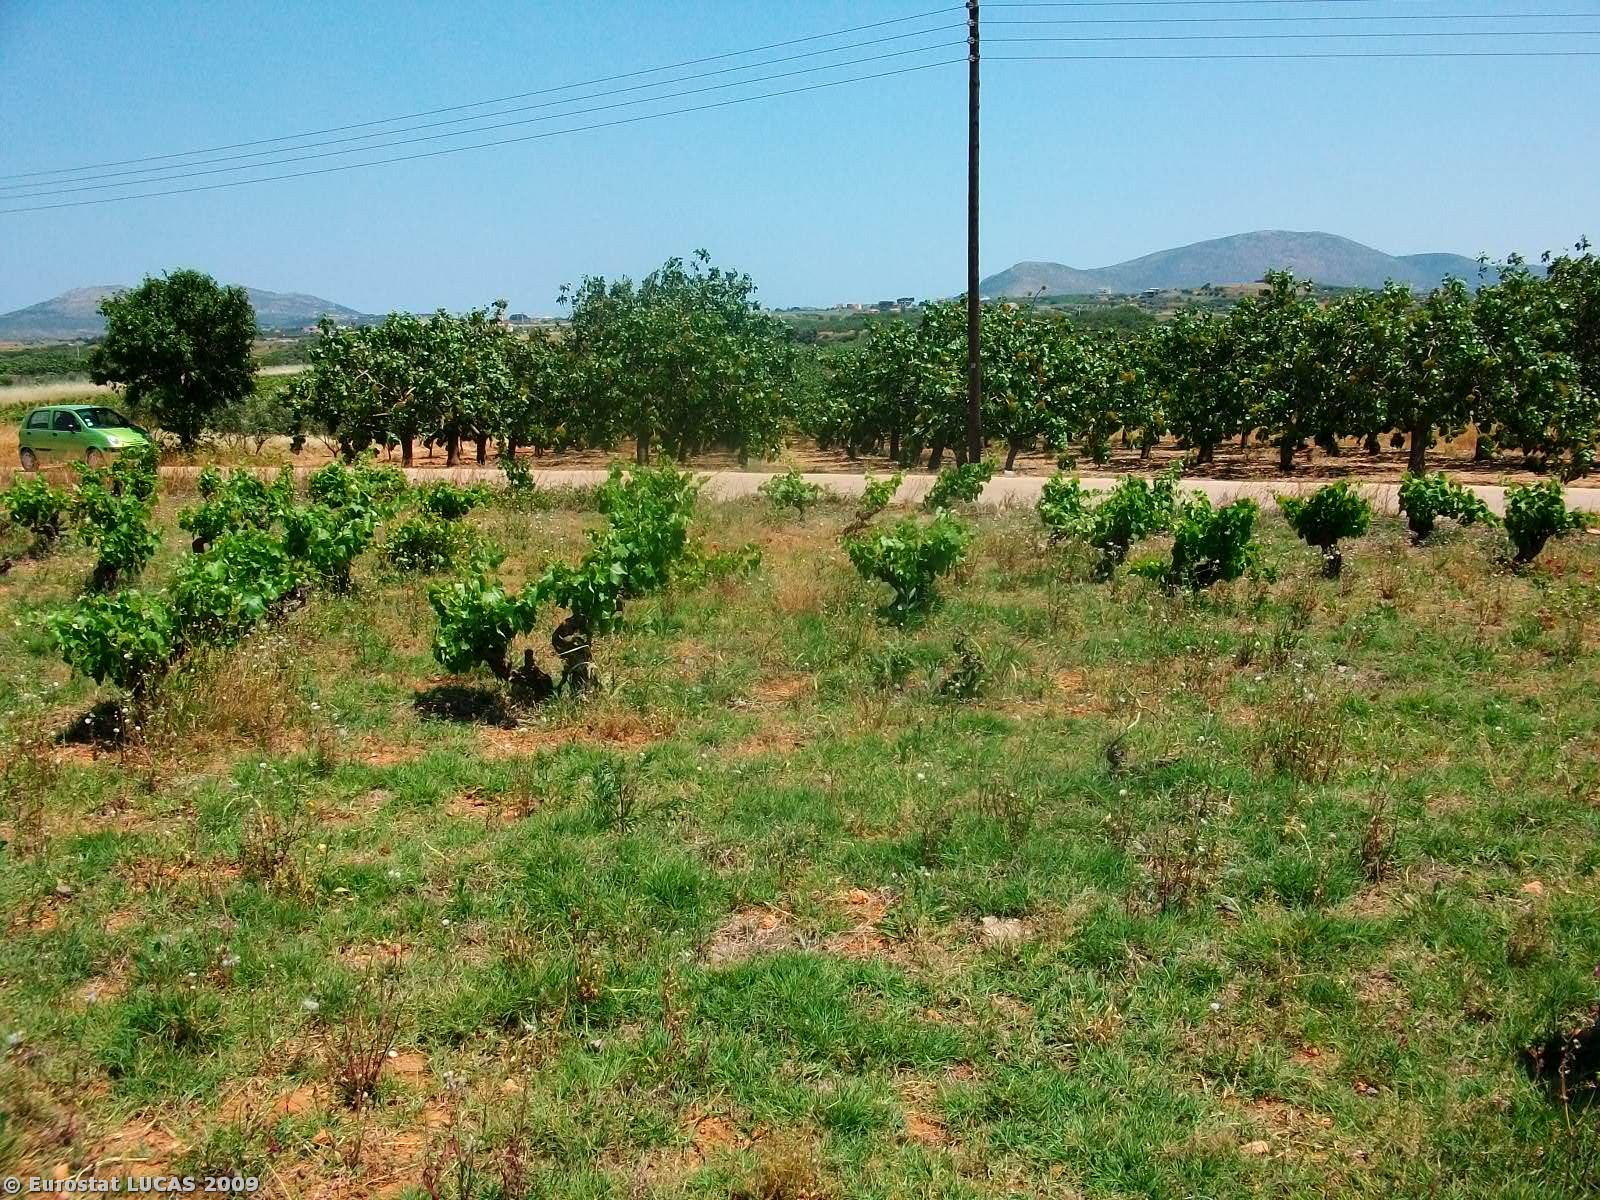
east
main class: Cropland
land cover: Vineyards
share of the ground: 25 - 50 %
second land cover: Grassland with sparse tree/shrub cover
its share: > 75 %
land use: Agriculture (excluding fallow land and kitchen gardens)
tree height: < 5 m
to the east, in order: Vineyards; Grassland with sparse tree/shrub cover; Grass margins; Paved roads, cycling and walking lanes; Electric lines; Nuts trees; Olive groves; Spontaneously vegetated surfaces; Vineyards; Spontaneously vegetated surfaces; Fences; Vineyards
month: May
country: GR
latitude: 37.9095
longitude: 23.9375
